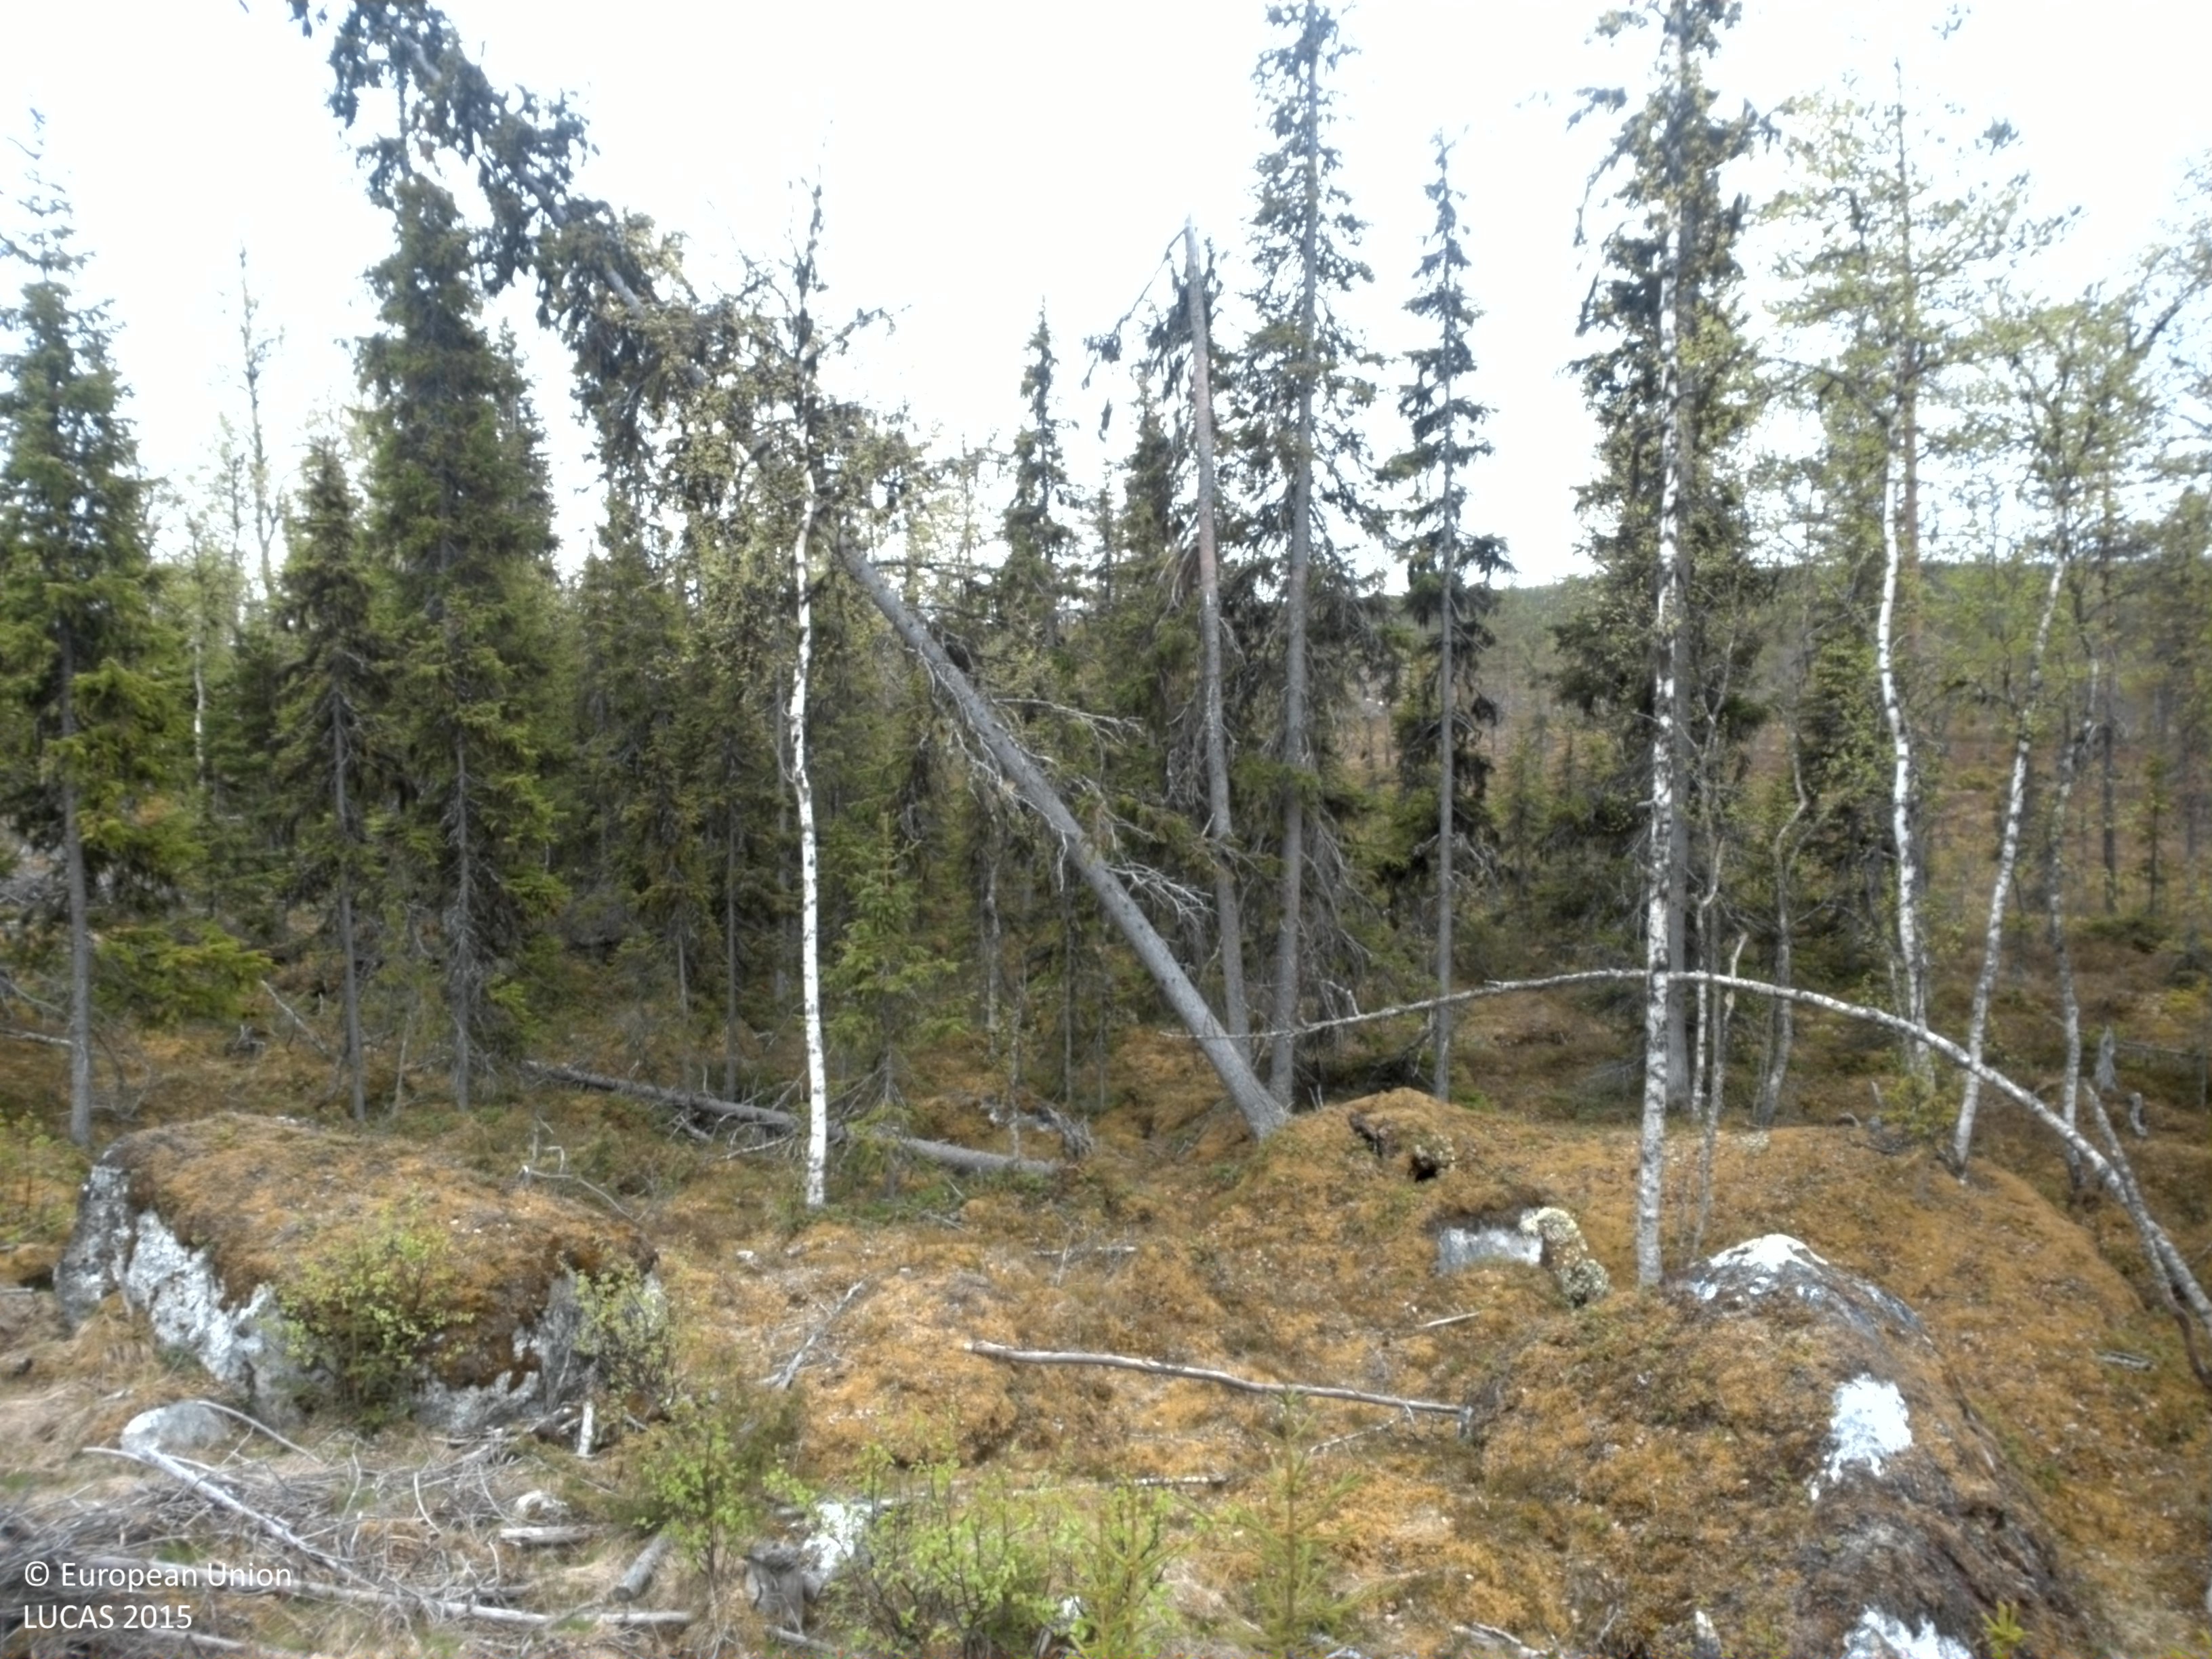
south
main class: Woodland
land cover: Spruce dominated coniferous woodland
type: boreal forest
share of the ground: 25 - 50 %
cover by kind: herbaceous plants 35 %, coniferous forest trees 30 %, unconsolidated bare surface 20 %, broadleaved forest trees 5 %, shrubs 5 %, lichens and mosses 5 %
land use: Forestry
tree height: < 5 m
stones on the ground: 25 - 50 %
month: June
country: SE
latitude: 64.3146
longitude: 17.4334
